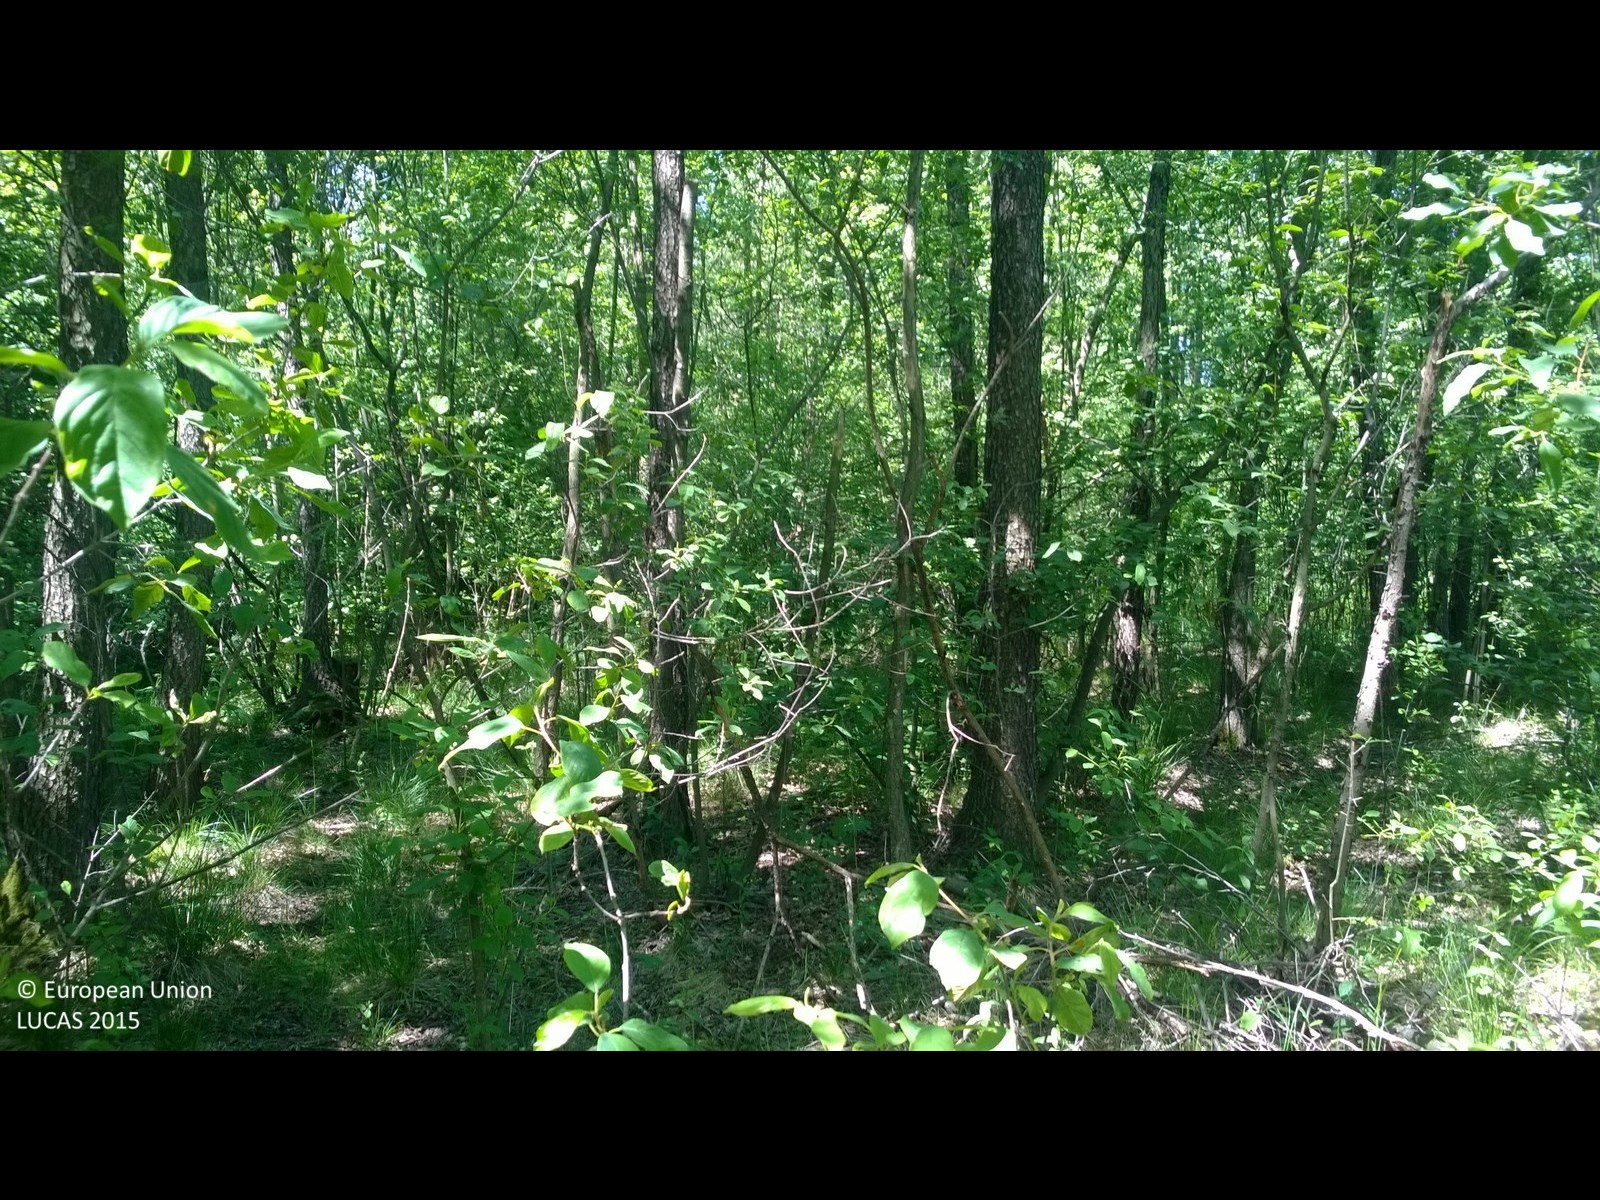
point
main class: Woodland
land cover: Broadleaved woodland
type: mesophytic deciduous forest
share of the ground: > 75 %
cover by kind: broadleaved forest trees 80 %, shrubs 15 %, herbaceous plants 5 %
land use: Forestry
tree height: > 5 m
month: June
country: PL
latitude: 53.0038
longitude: 23.3590
